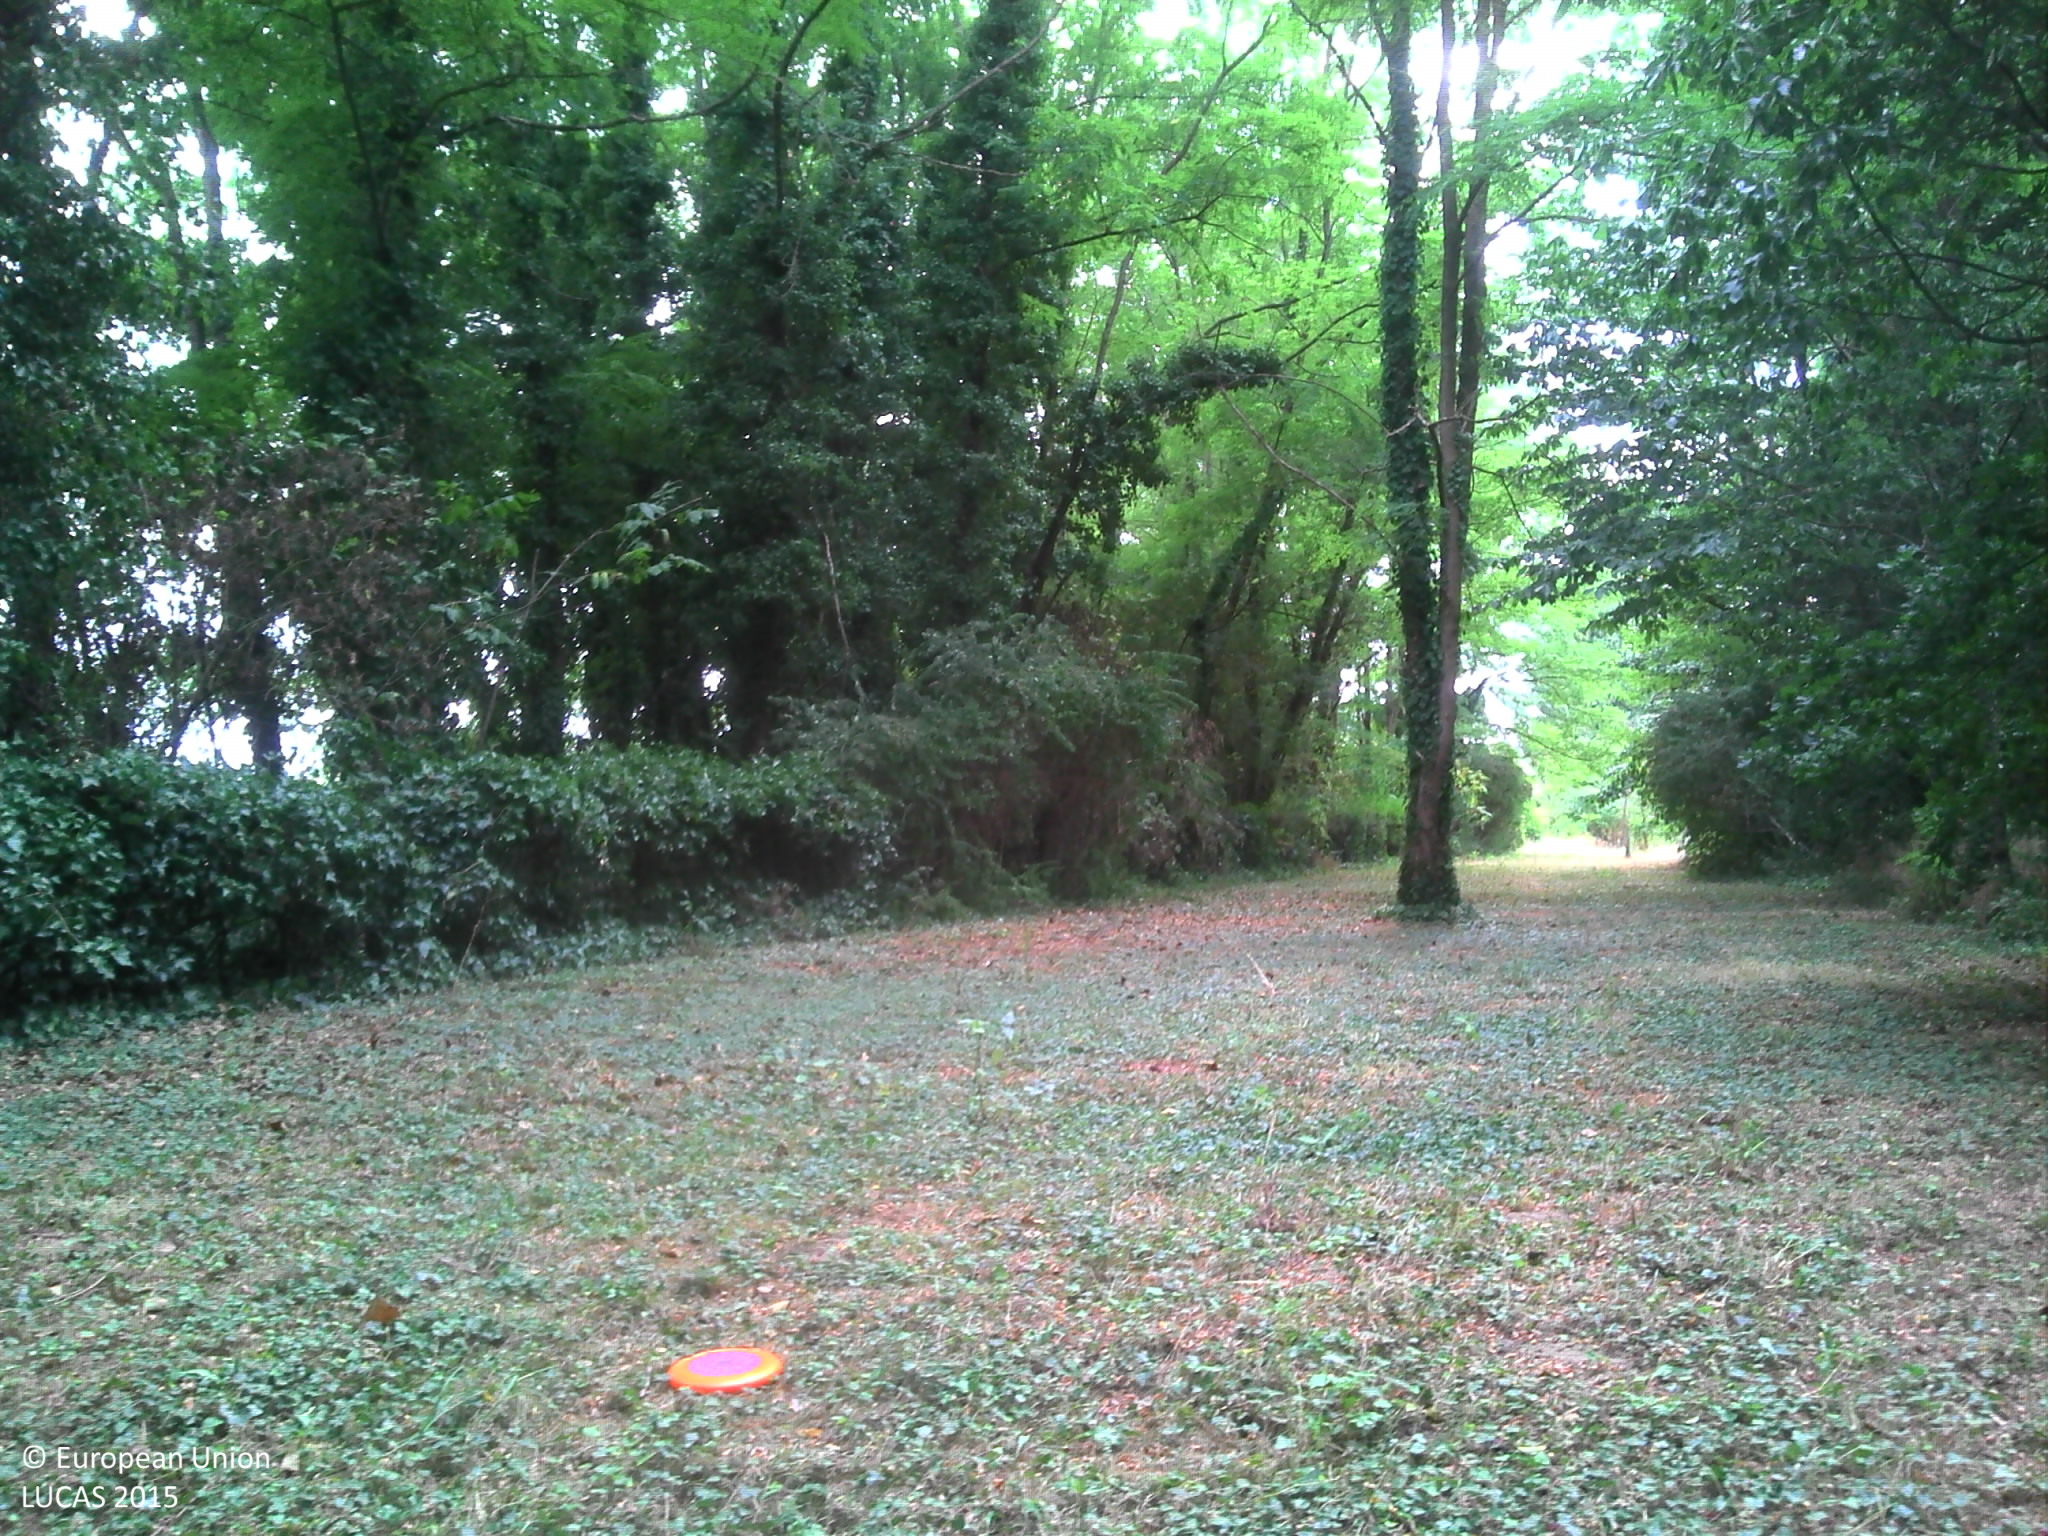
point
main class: Woodland
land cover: Other mixed woodland
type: hemiboreal forest and nemoral coniferous forest and mixed broadleaved-coniferous forest
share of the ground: > 75 %
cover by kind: coniferous forest trees 45 %, herbaceous plants 30 %, broadleaved forest trees 25 %
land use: Forestry
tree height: > 5 m
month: July
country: FR
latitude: 46.8456
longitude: 4.9526
